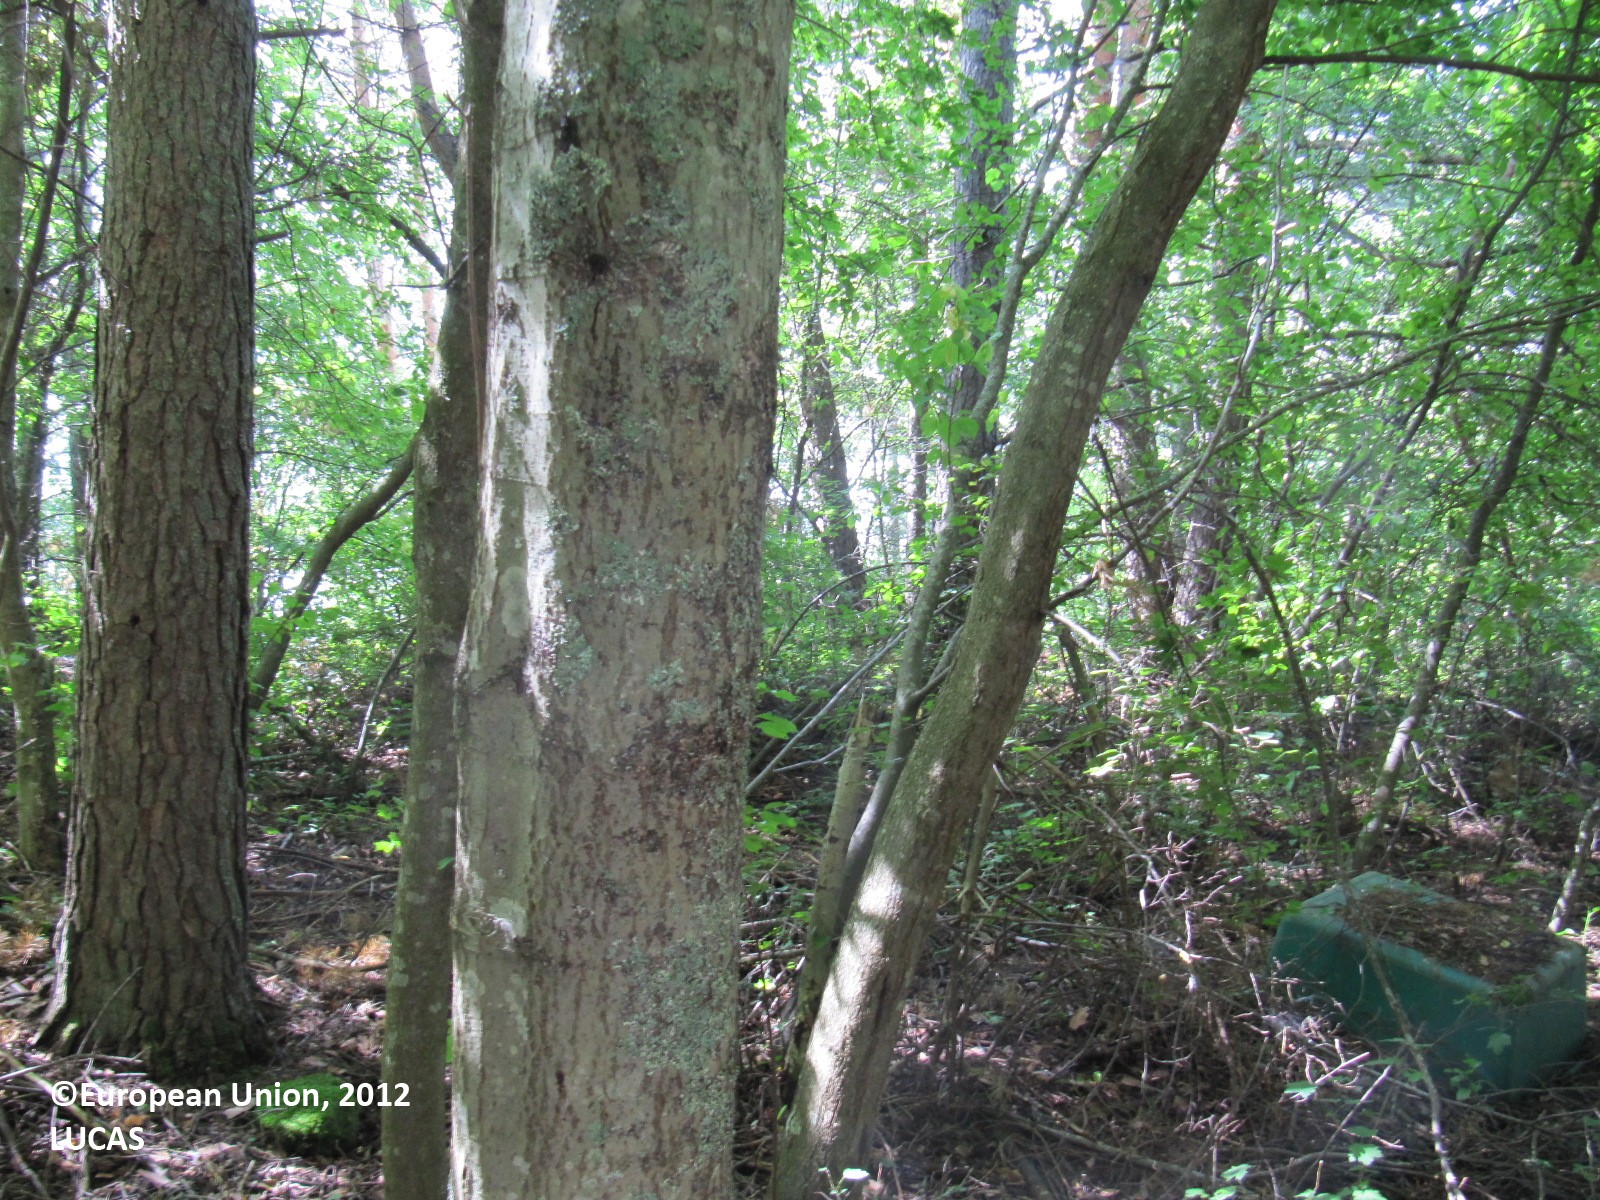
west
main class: Woodland
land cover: Broadleaved woodland
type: boreal forest
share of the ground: > 75 %
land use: Forestry
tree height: > 5 m
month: July
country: FI
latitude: 61.1654
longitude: 24.5447
